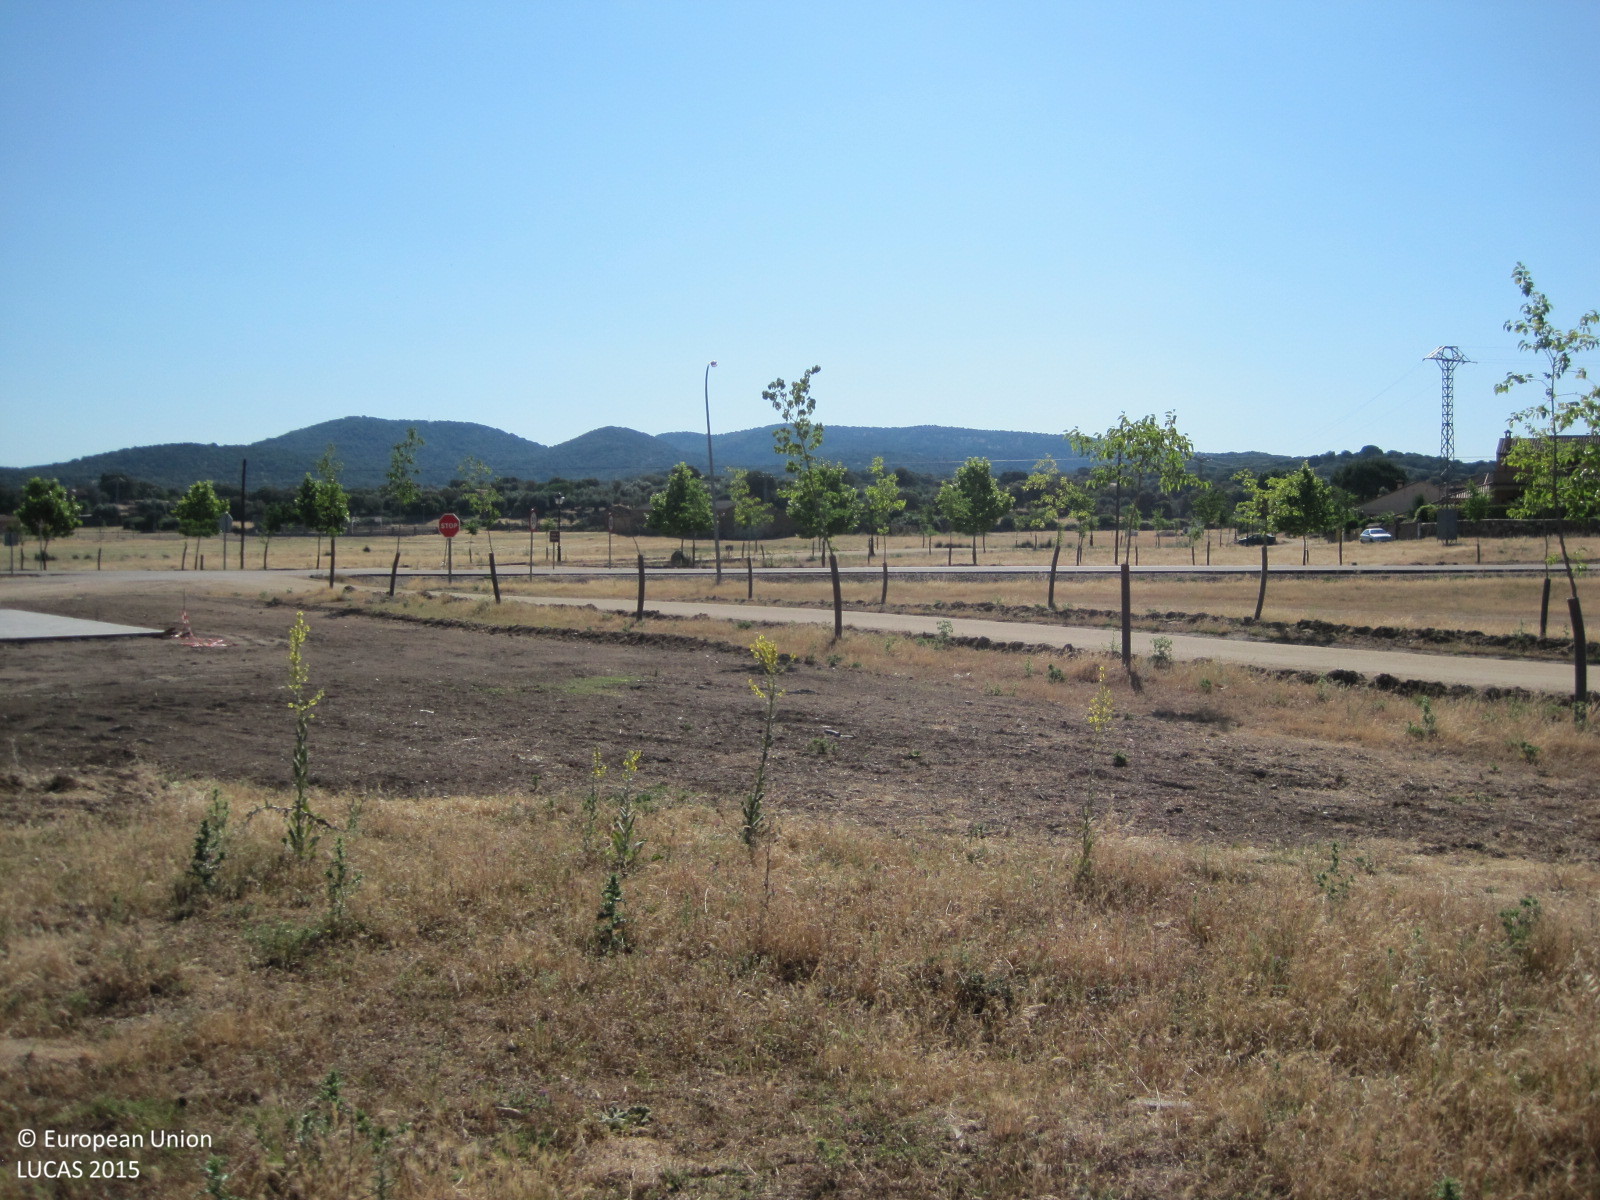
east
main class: Grassland
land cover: Grassland without tree/shrub cover
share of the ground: > 75 %
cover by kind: herbaceous plants 100 %
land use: Agriculture (excluding fallow land and kitchen gardens)
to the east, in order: Grassland without tree/shrub cover; Other bare soil; Lines of trees; Grass margins; Tracks; Grass margins; Lines of trees; Grassland without tree/shrub cover; Grass margins; Paved roads, cycling and walking lanes; Grass margins; Lines of trees; Grassland without tree/shrub cover; Electric lines; Grassland without tree/shrub cover; Tracks; Grassland without tree/shrub cover; Dry stone walls
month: May
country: ES
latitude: 40.2281
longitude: -4.7527
